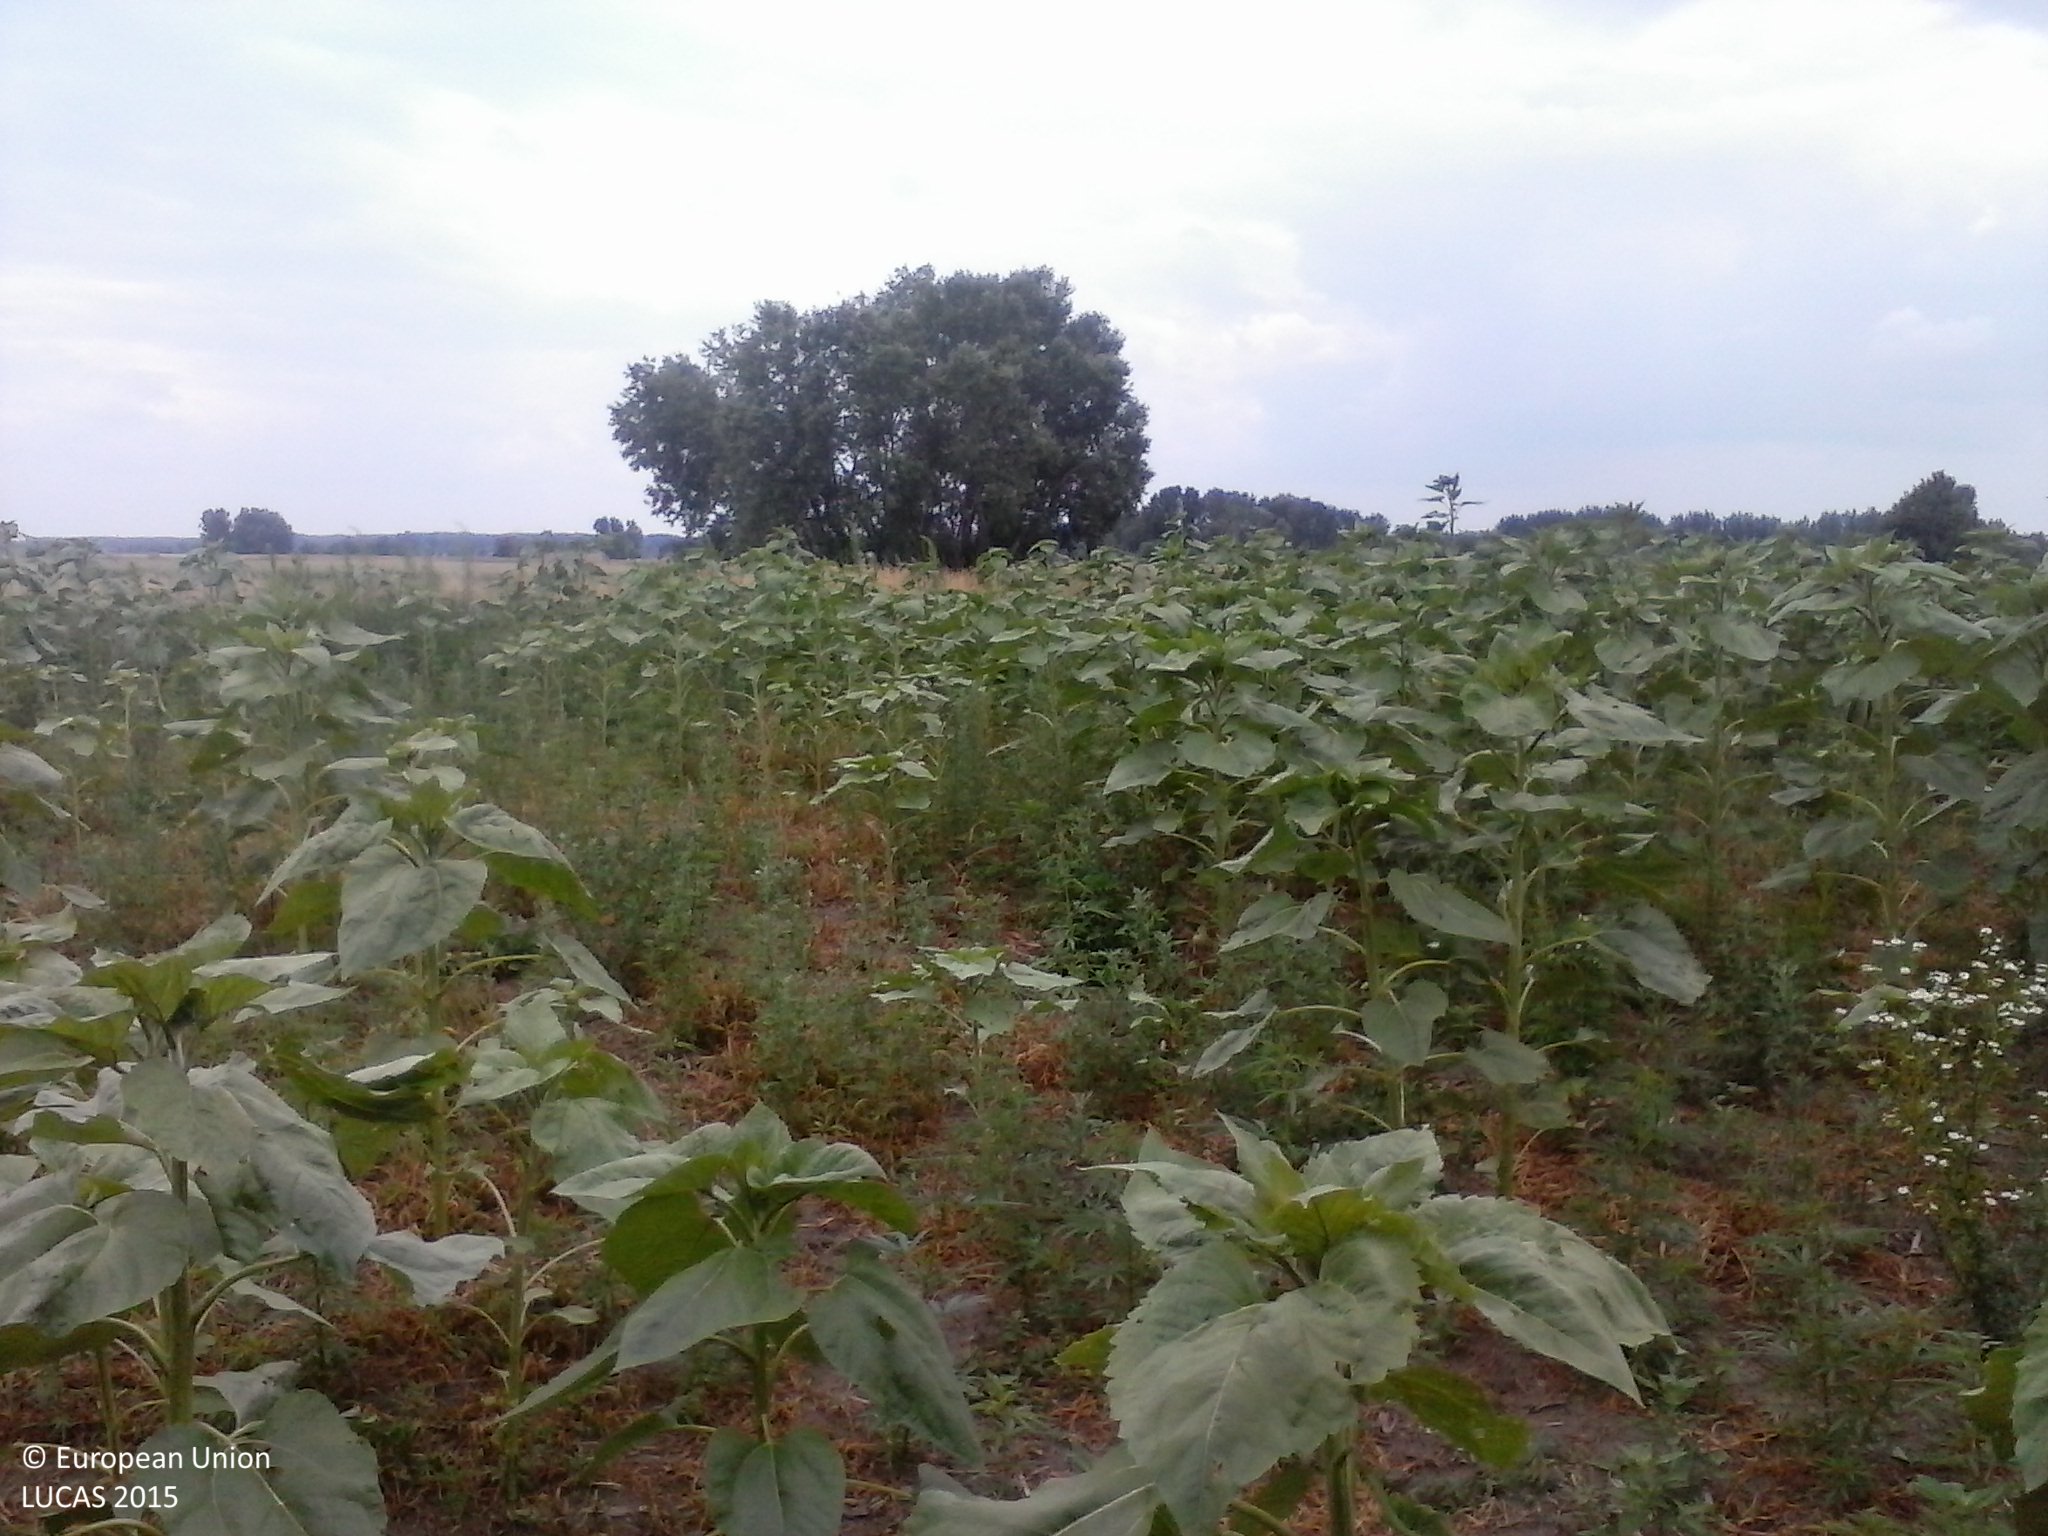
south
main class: Cropland
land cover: Sunflower
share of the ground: > 75 %
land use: Agriculture (excluding fallow land and kitchen gardens)
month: June
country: HU
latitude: 46.2494
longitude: 19.5503
